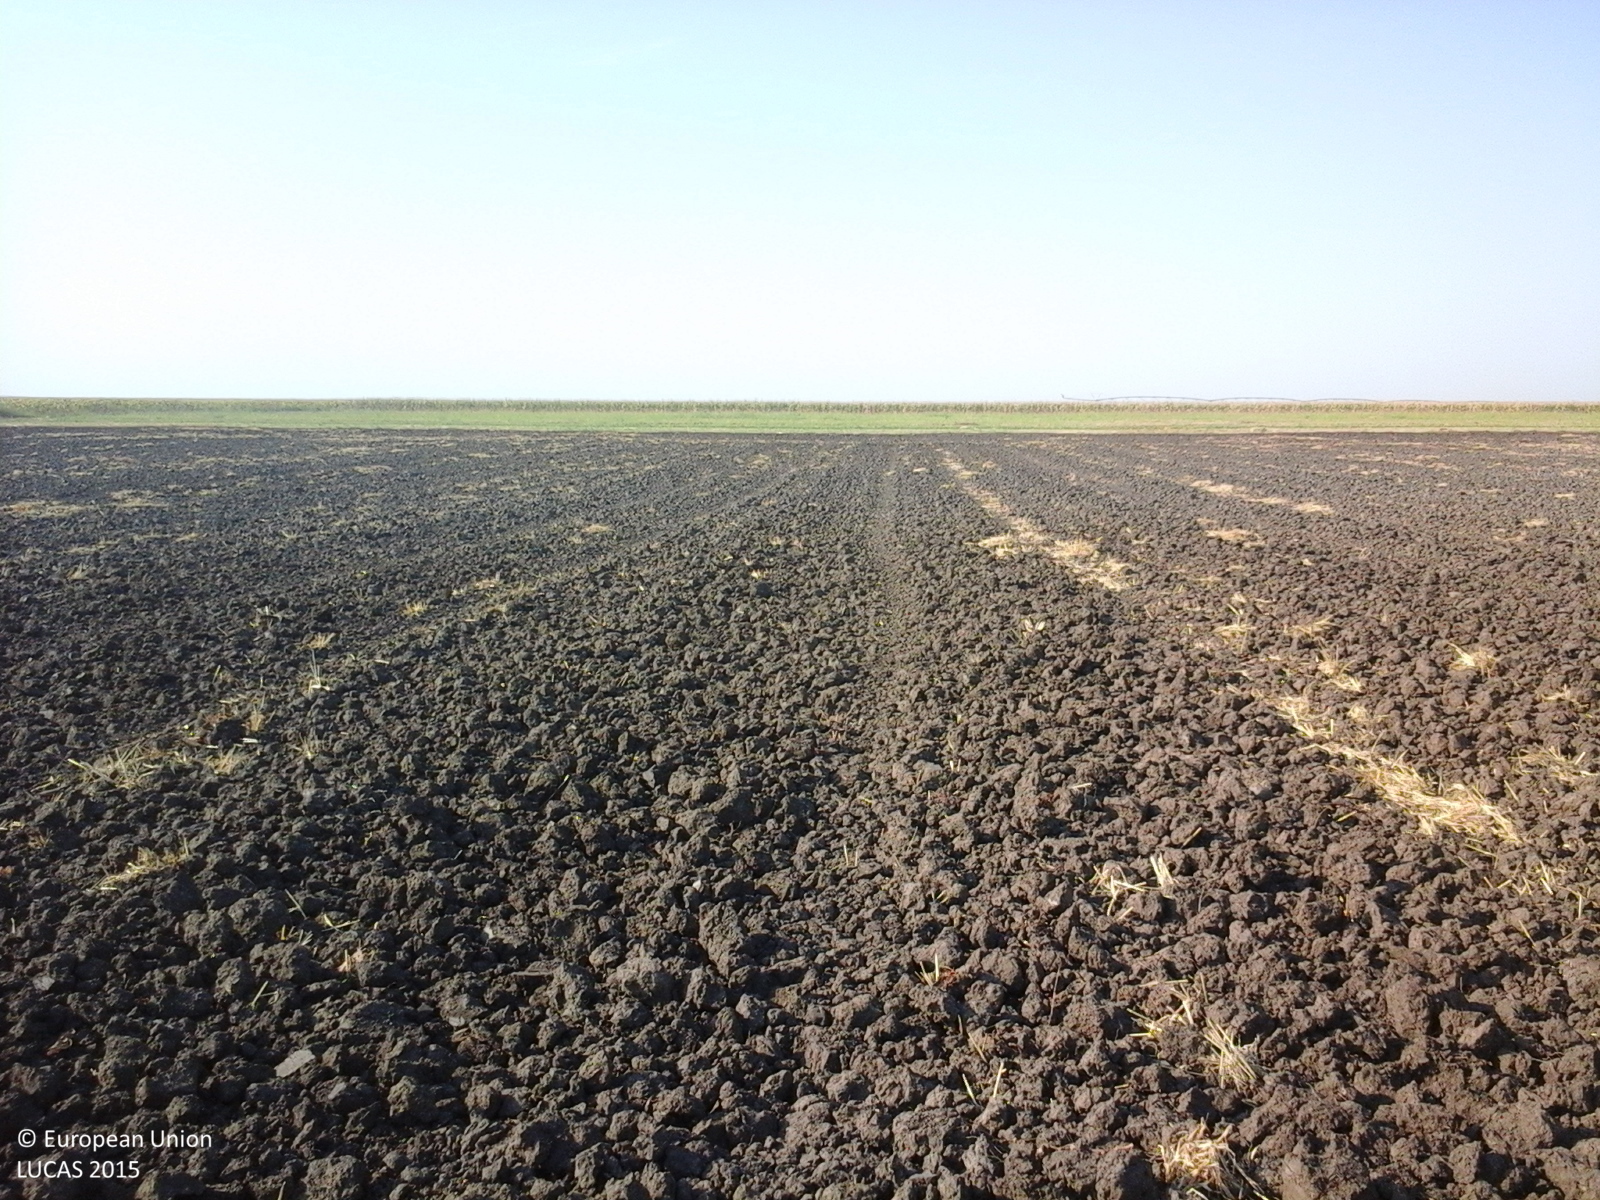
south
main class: Cropland
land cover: Common wheat
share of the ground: < 10 %
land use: Agriculture (excluding fallow land and kitchen gardens)
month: August
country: RO
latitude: 43.9990
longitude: 23.7332
